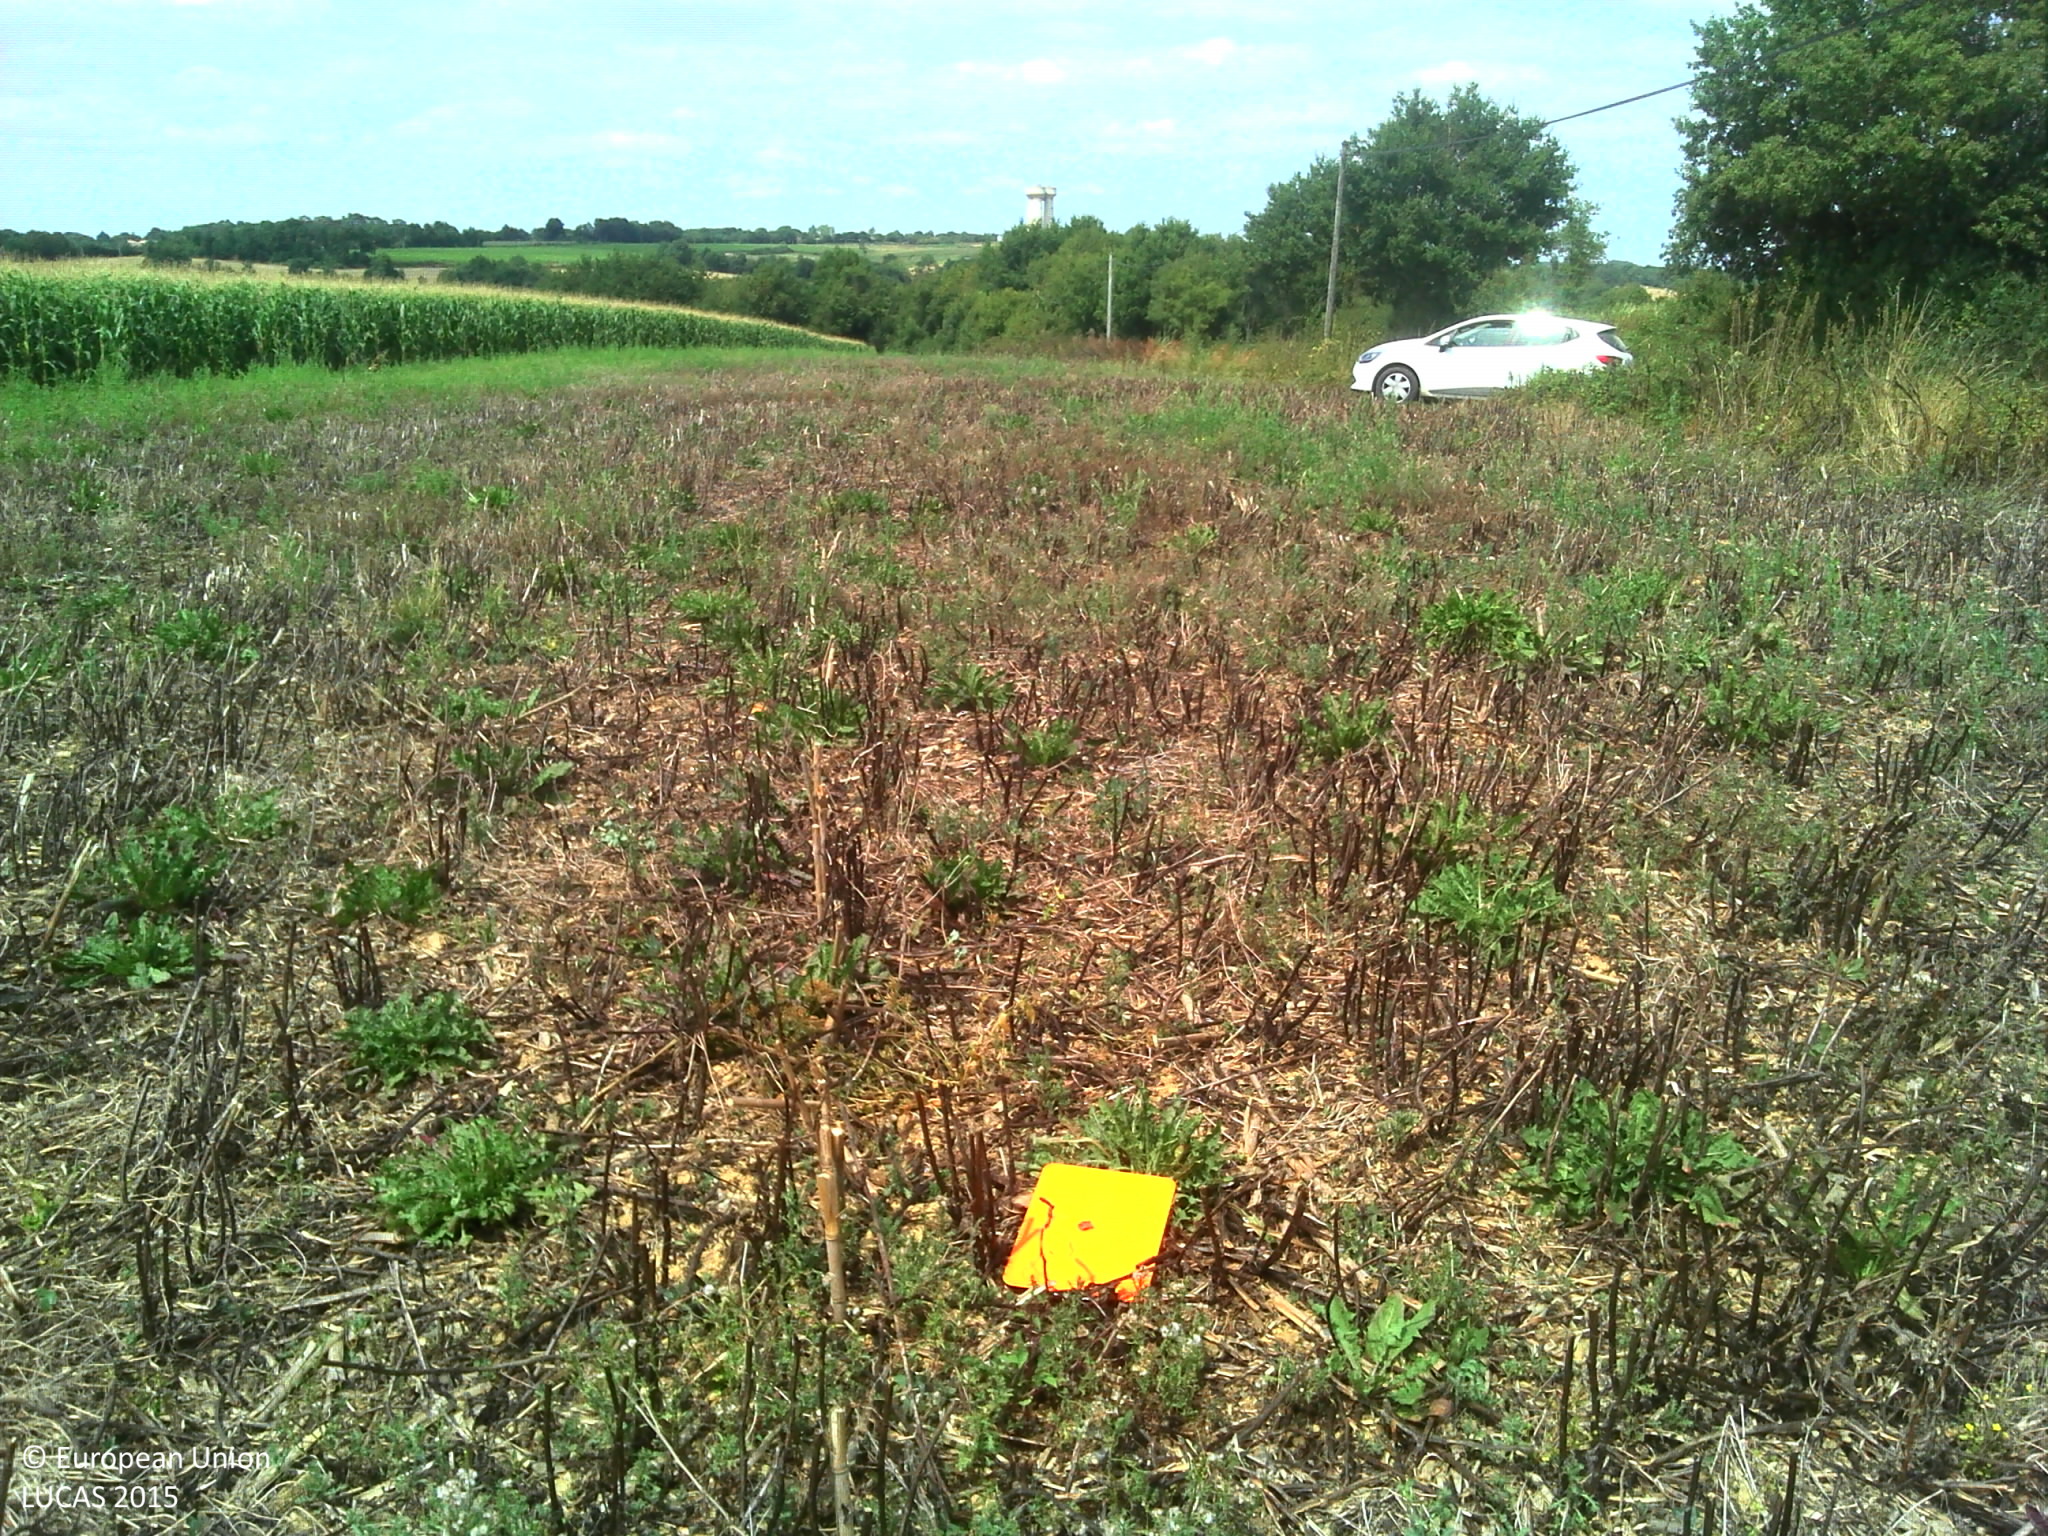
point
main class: Cropland
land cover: Dry pulses
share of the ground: > 75 %
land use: Agriculture (excluding fallow land and kitchen gardens)
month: August
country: FR
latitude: 46.6288
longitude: -1.0699
